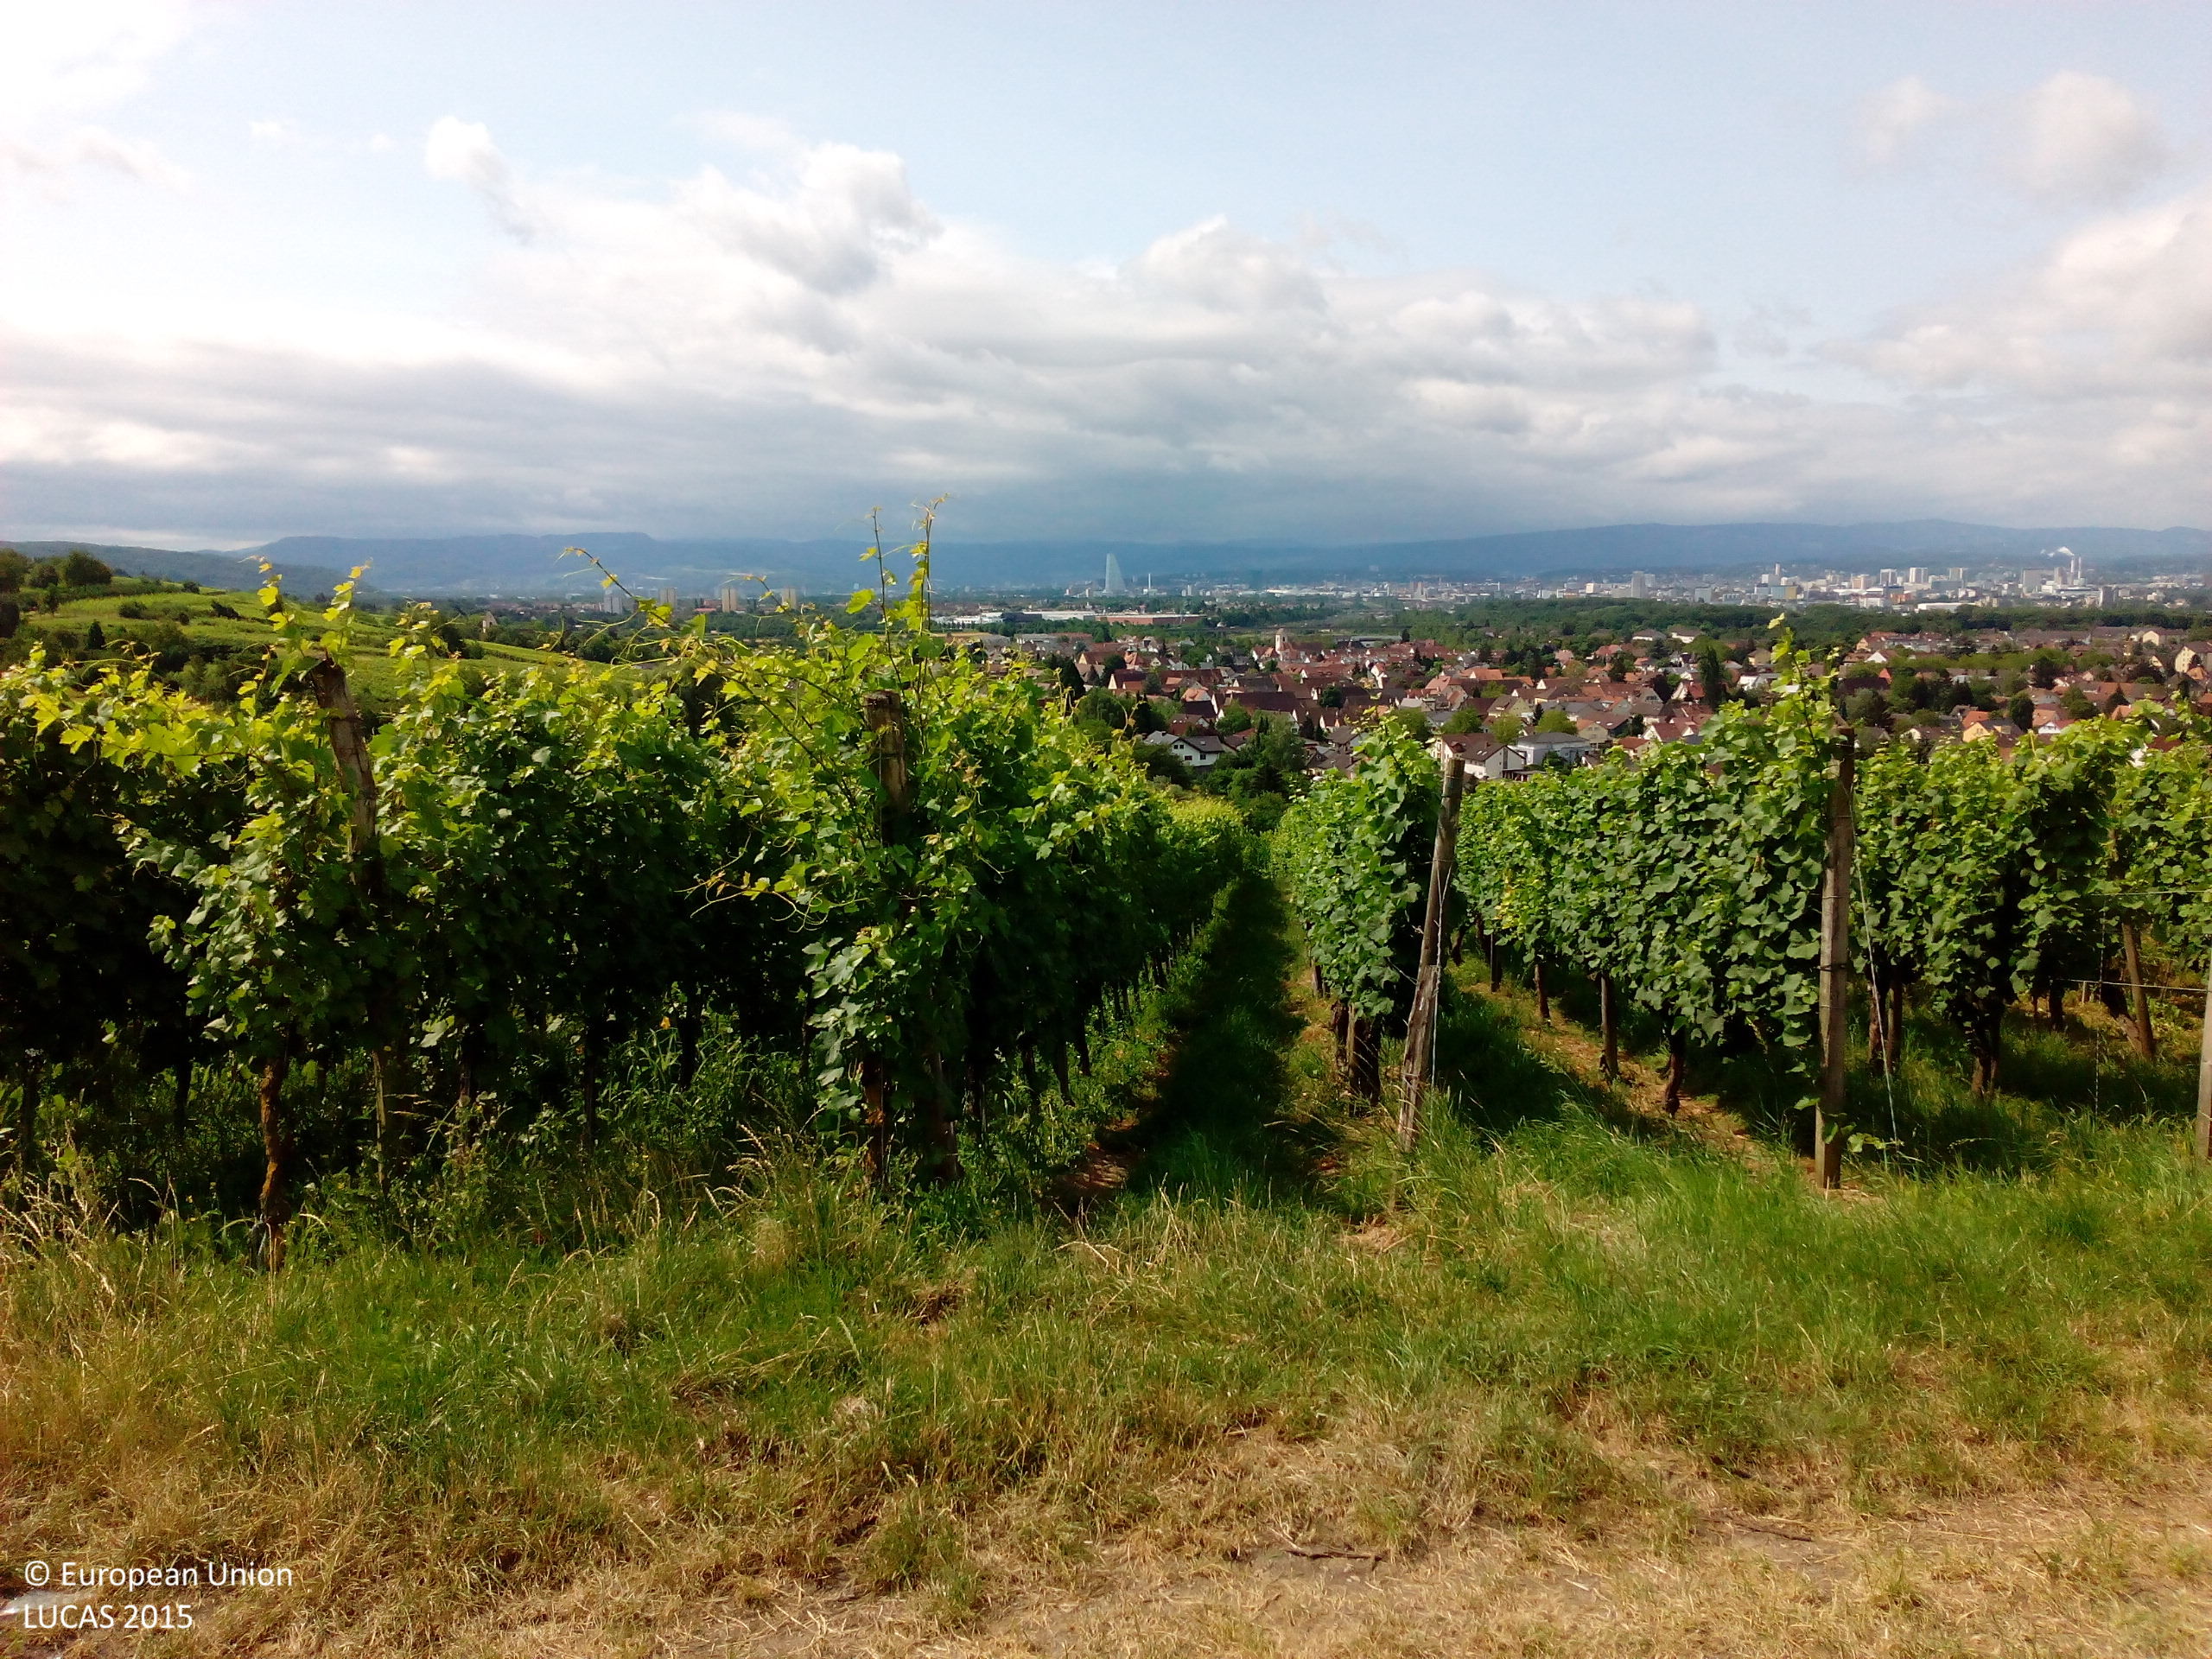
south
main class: Cropland
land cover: Vineyards
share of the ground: 25 - 50 %
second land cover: Grassland without tree/shrub cover
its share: 50 - 75 %
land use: Agriculture (excluding fallow land and kitchen gardens)
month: July
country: DE
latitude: 47.6217
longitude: 7.6198
